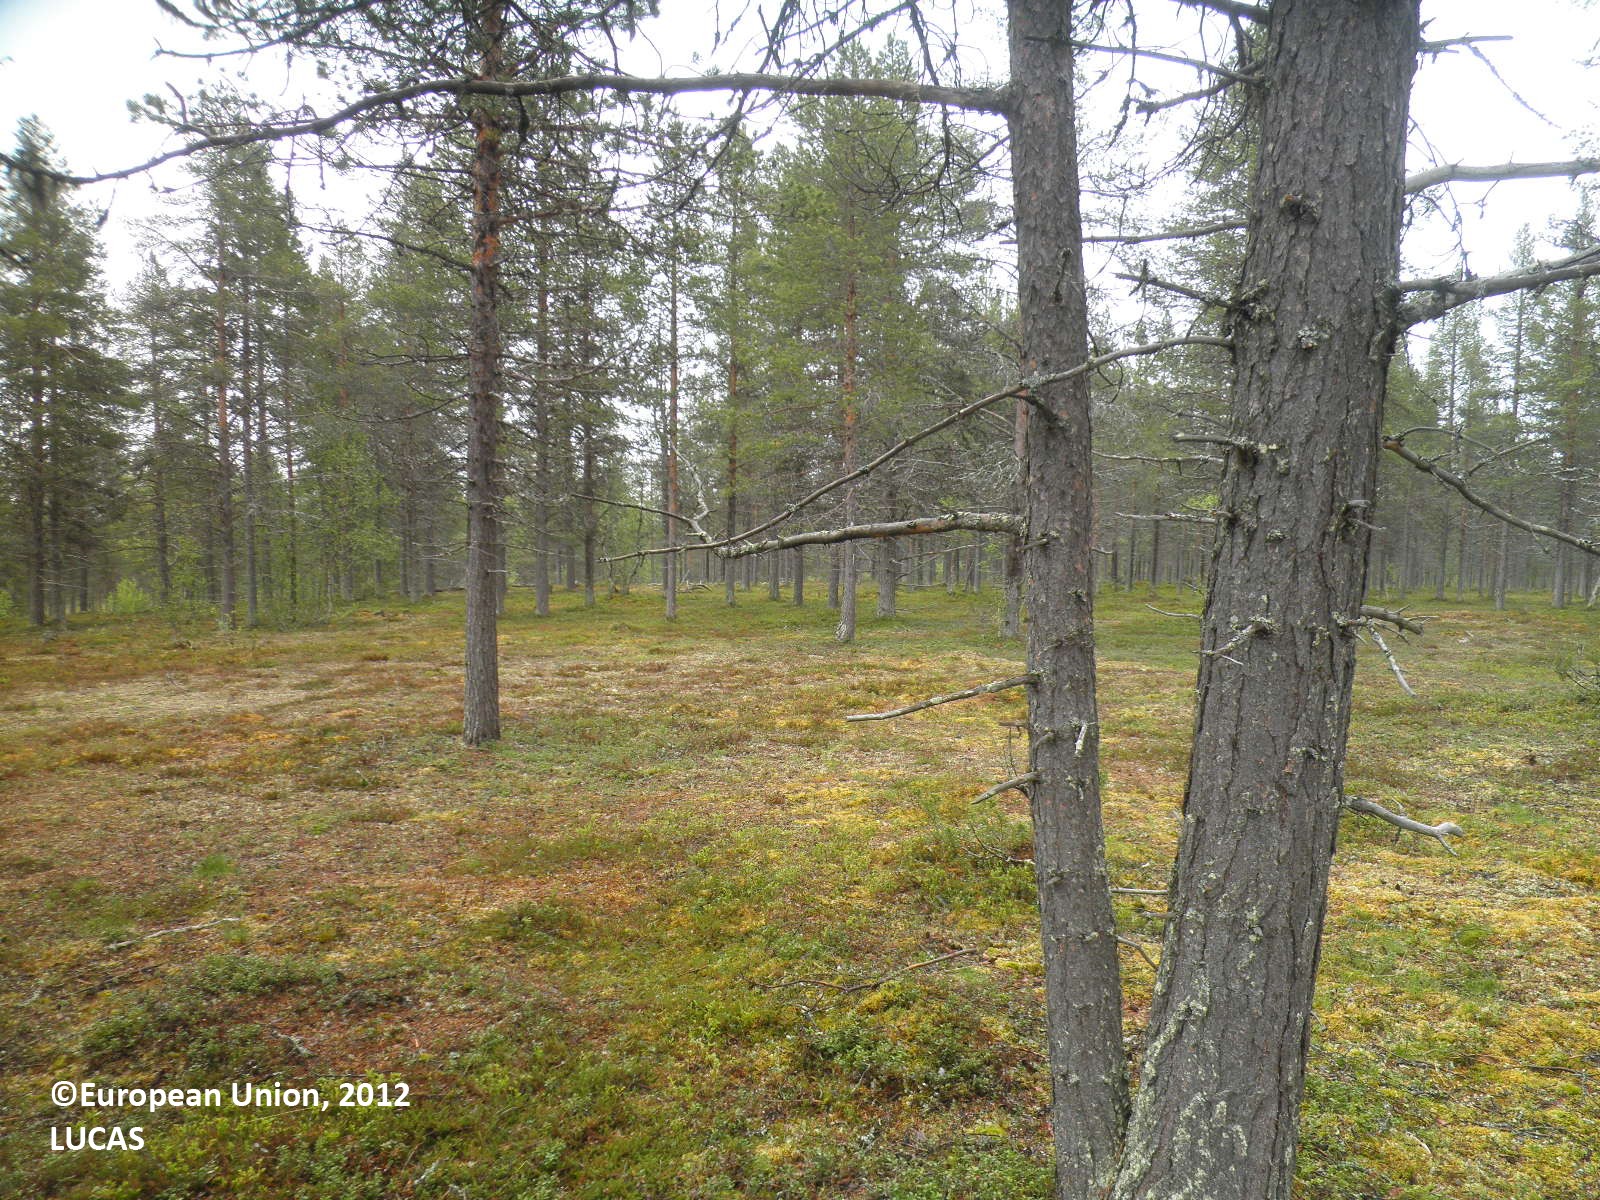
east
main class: Woodland
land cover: Pine dominated coniferous woodland
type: boreal forest
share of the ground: 25 - 50 %
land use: Forestry
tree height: > 5 m
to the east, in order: Pine dominated coniferous woodland; Pine dominated mixed woodland
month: June
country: FI
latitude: 68.1649
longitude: 25.7765
